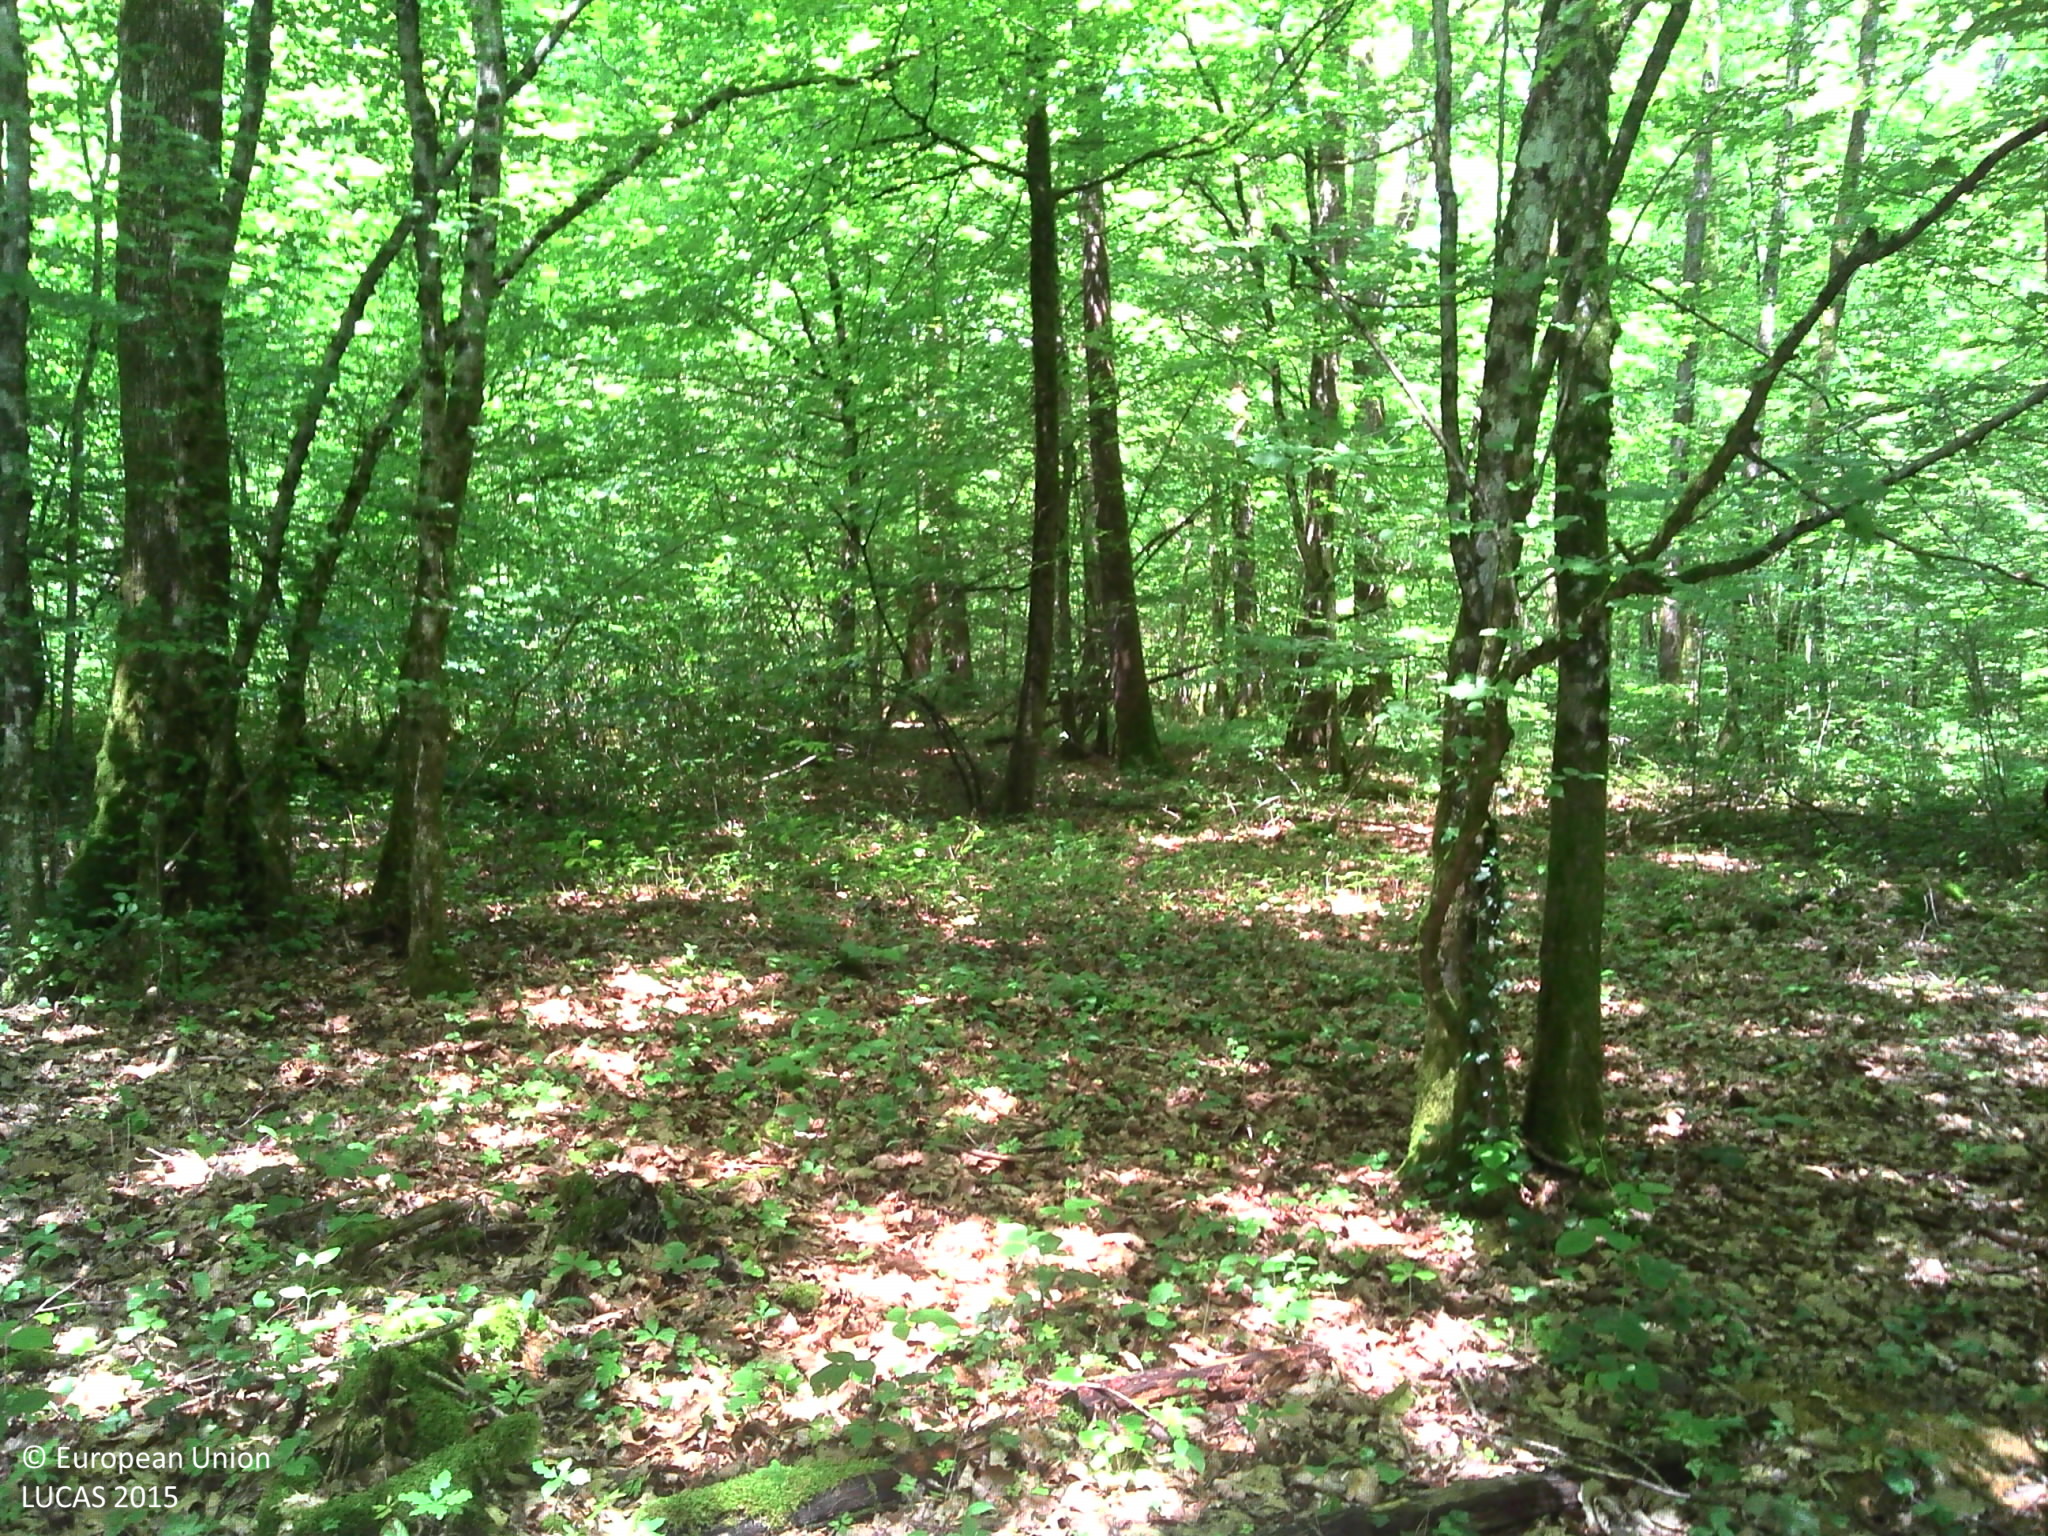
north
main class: Woodland
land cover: Broadleaved woodland
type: beech forest
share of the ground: > 75 %
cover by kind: broadleaved forest trees 90 %, herbaceous plants 10 %
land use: Forestry
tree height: > 5 m
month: June
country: FR
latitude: 48.5261
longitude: 5.0290
